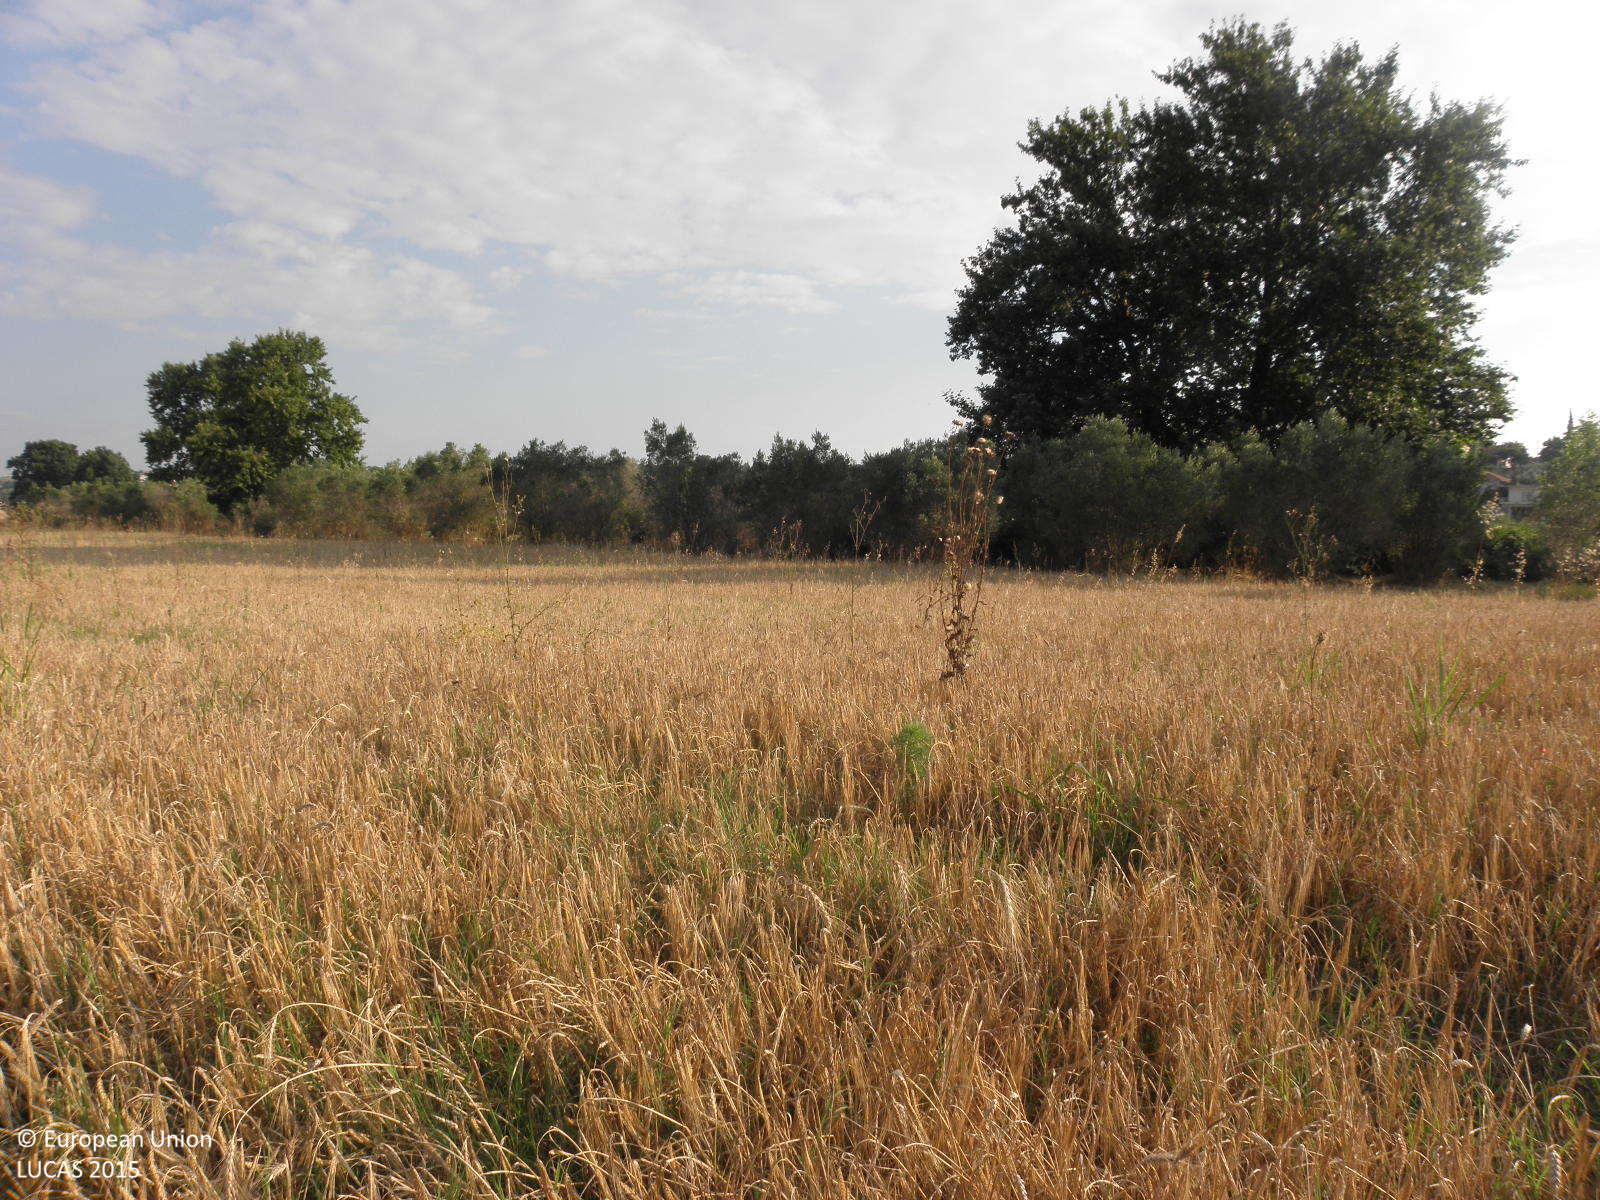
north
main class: Cropland
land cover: Durum wheat
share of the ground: > 75 %
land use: Agriculture (excluding fallow land and kitchen gardens)
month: June
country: GR
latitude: 40.3197
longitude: 22.5323
